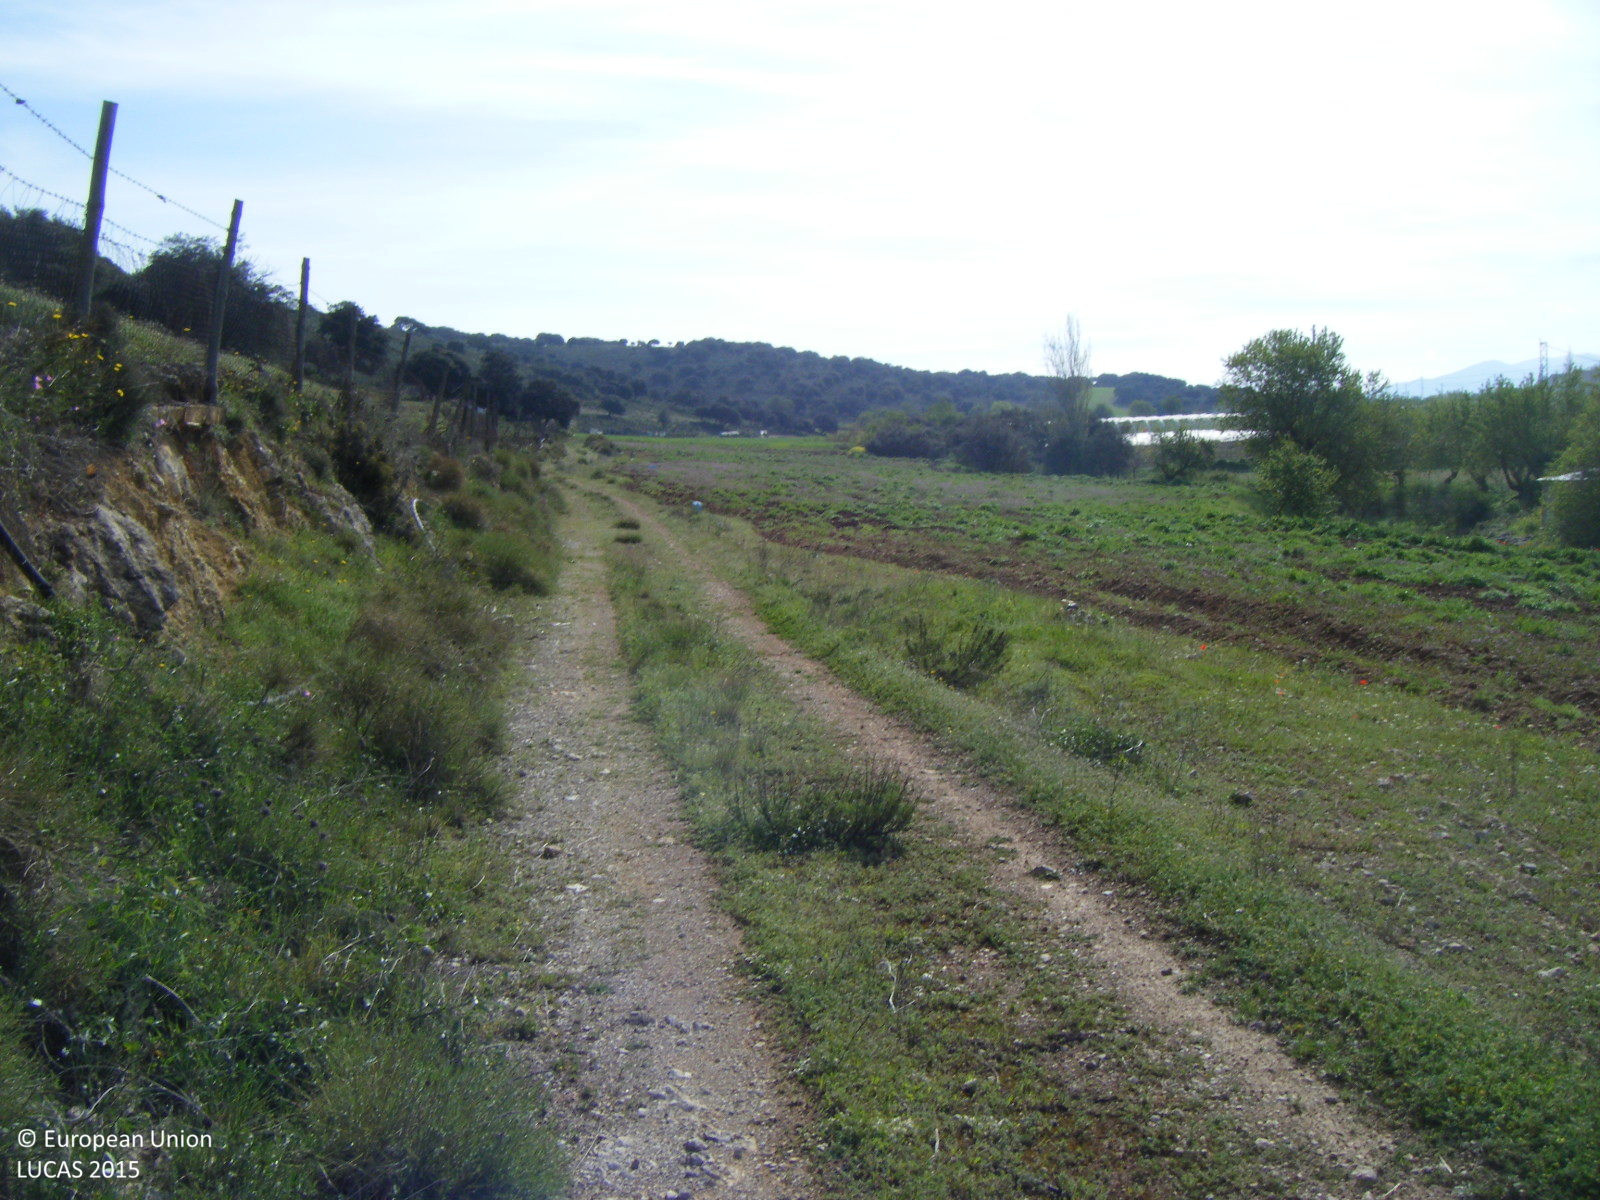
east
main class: Shrubland
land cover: Shrubland without tree cover
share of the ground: 25 - 50 %
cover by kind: herbaceous plants 60 %, shrubs 40 %
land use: Agriculture (excluding fallow land and kitchen gardens)
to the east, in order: Shrubland without tree cover; Rock outcrops; Shrubland without tree cover
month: April
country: ES
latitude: 36.9543
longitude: -4.0617
